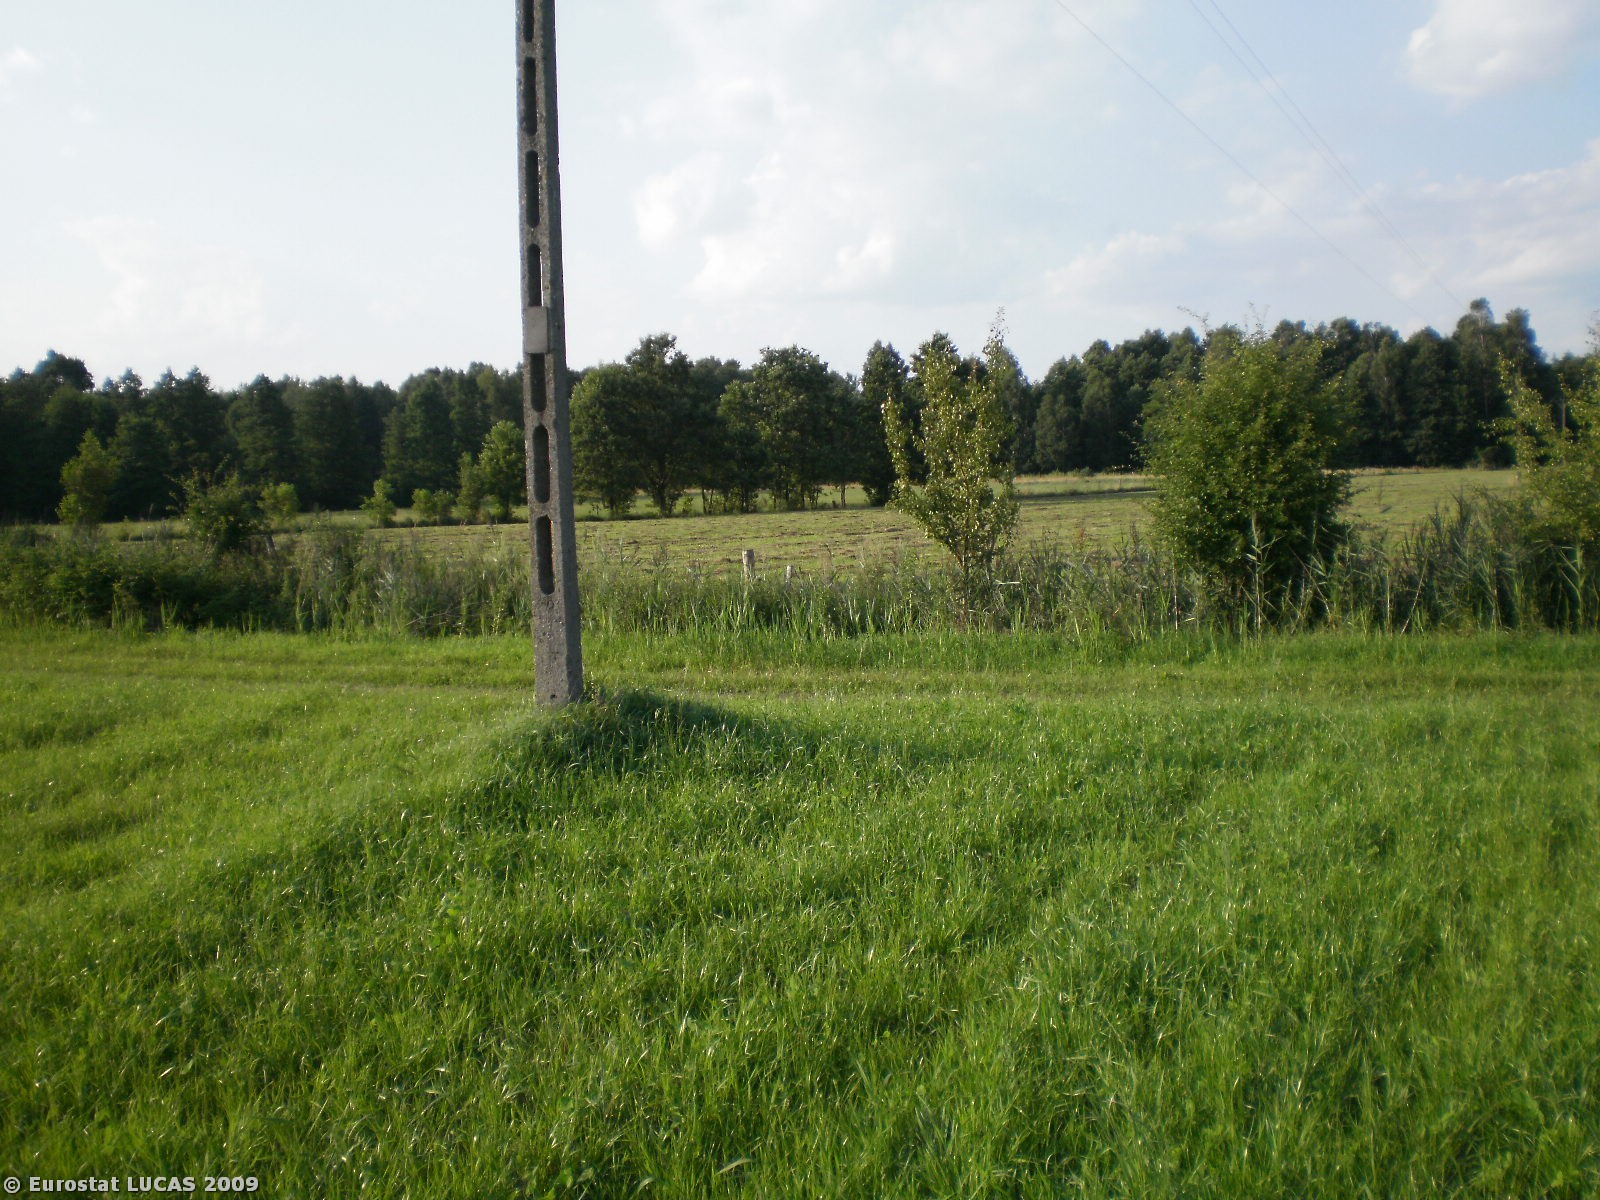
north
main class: Grassland
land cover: Grassland without tree/shrub cover
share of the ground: > 75 %
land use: Agriculture (excluding fallow land and kitchen gardens)
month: July
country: PL
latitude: 53.4498
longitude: 21.3259
